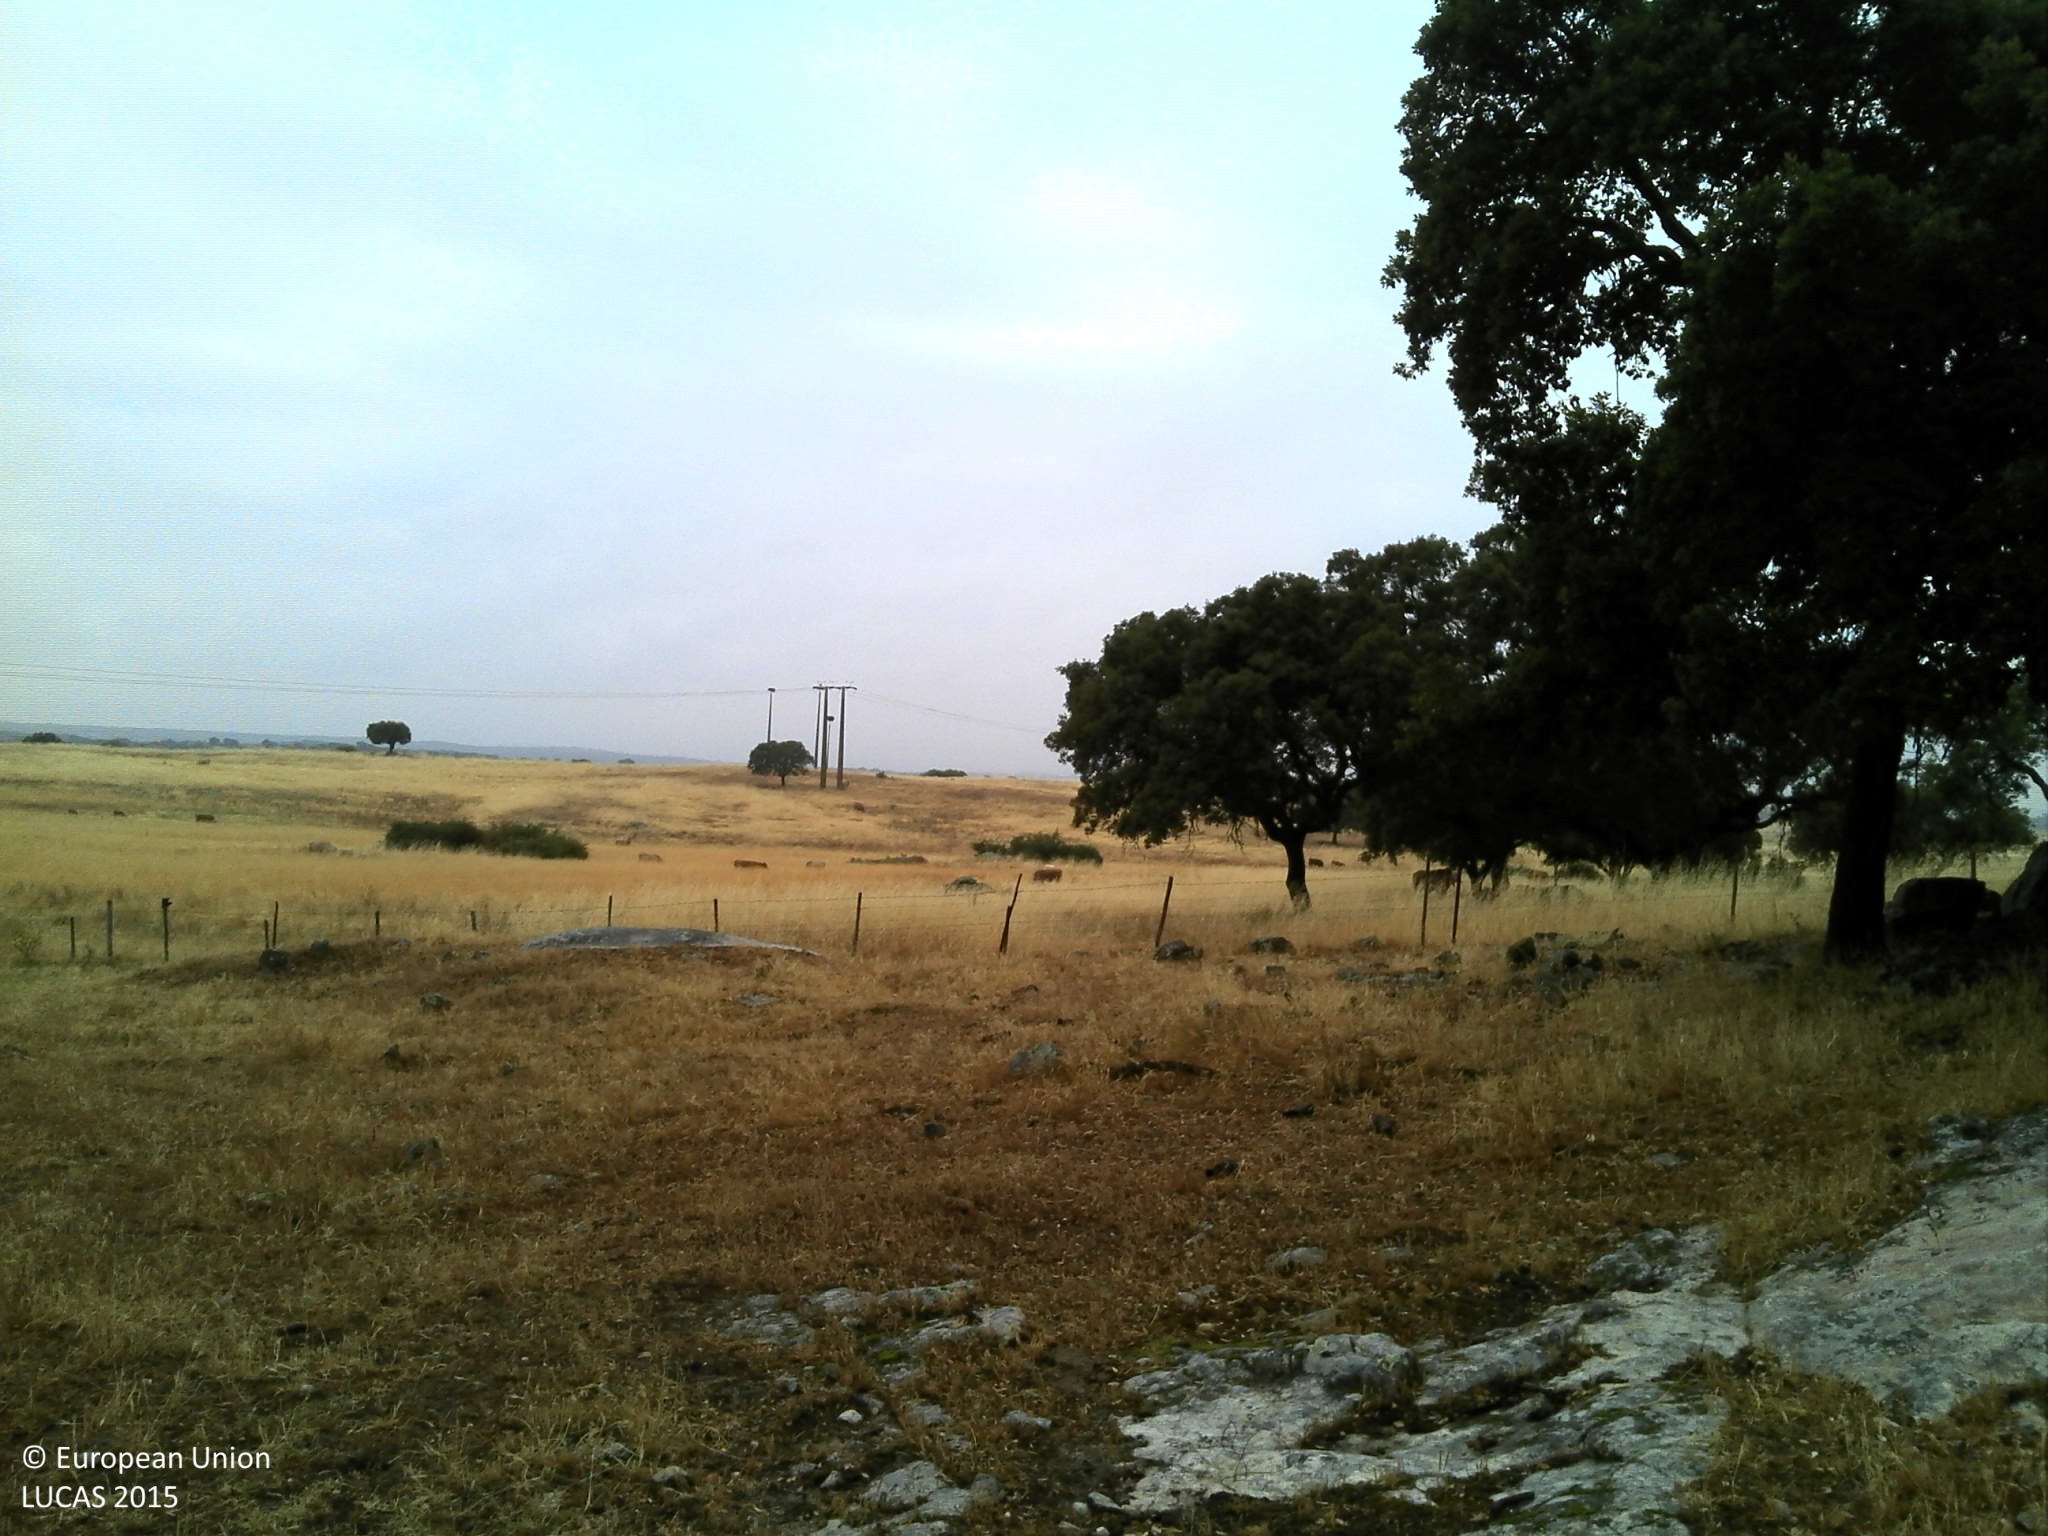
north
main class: Woodland
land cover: Broadleaved woodland
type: broadleaved evergreen forest
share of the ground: 25 - 50 %
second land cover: Grassland without tree/shrub cover
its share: 25 - 50 %
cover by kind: unconsolidated bare surface 40 %, broadleaved forest trees 30 %, herbaceous plants 30 %
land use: Forestry
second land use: Agriculture (excluding fallow land and kitchen gardens)
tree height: > 5 m
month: June
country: PT
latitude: 38.3921
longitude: -7.9553
